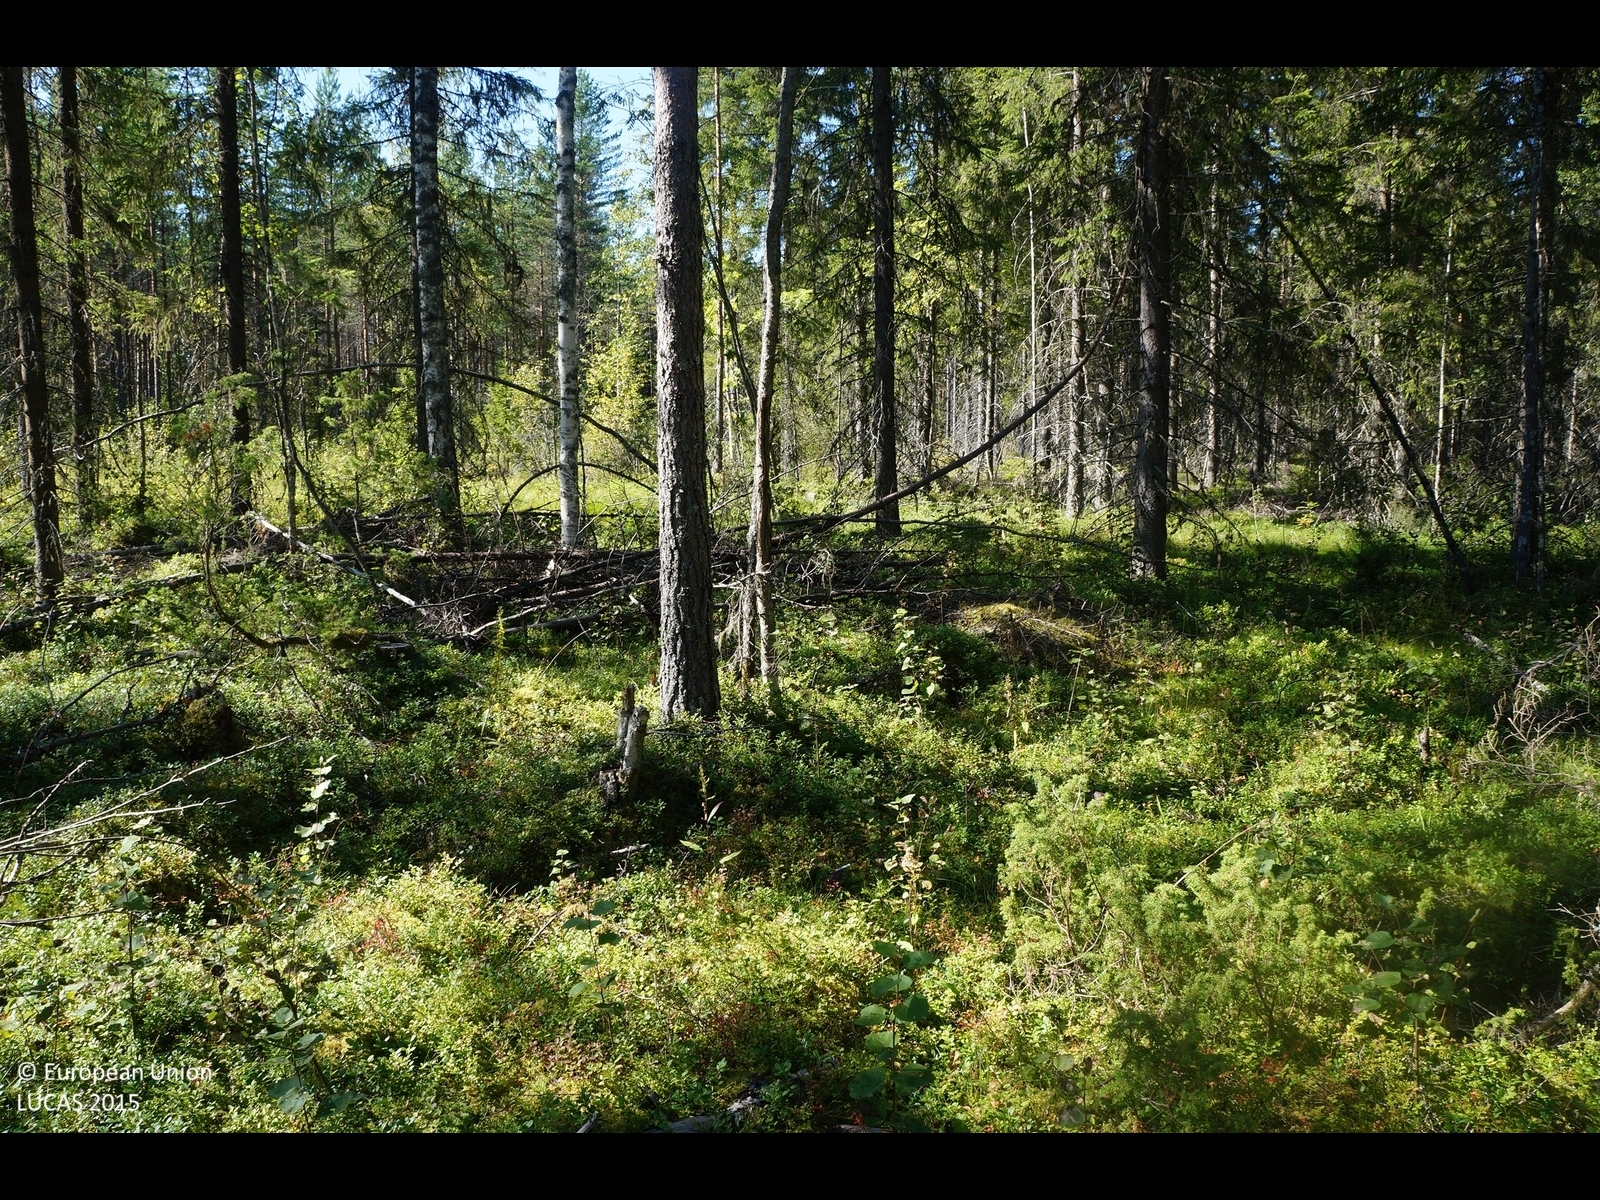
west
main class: Woodland
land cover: Spruce dominated coniferous woodland
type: boreal forest
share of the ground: 50 - 75 %
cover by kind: coniferous forest trees 50 %, shrubs 35 %, lichens and mosses 10 %, herbaceous plants 5 %
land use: Forestry
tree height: > 5 m
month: August
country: FI
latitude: 64.0141
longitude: 25.1643
